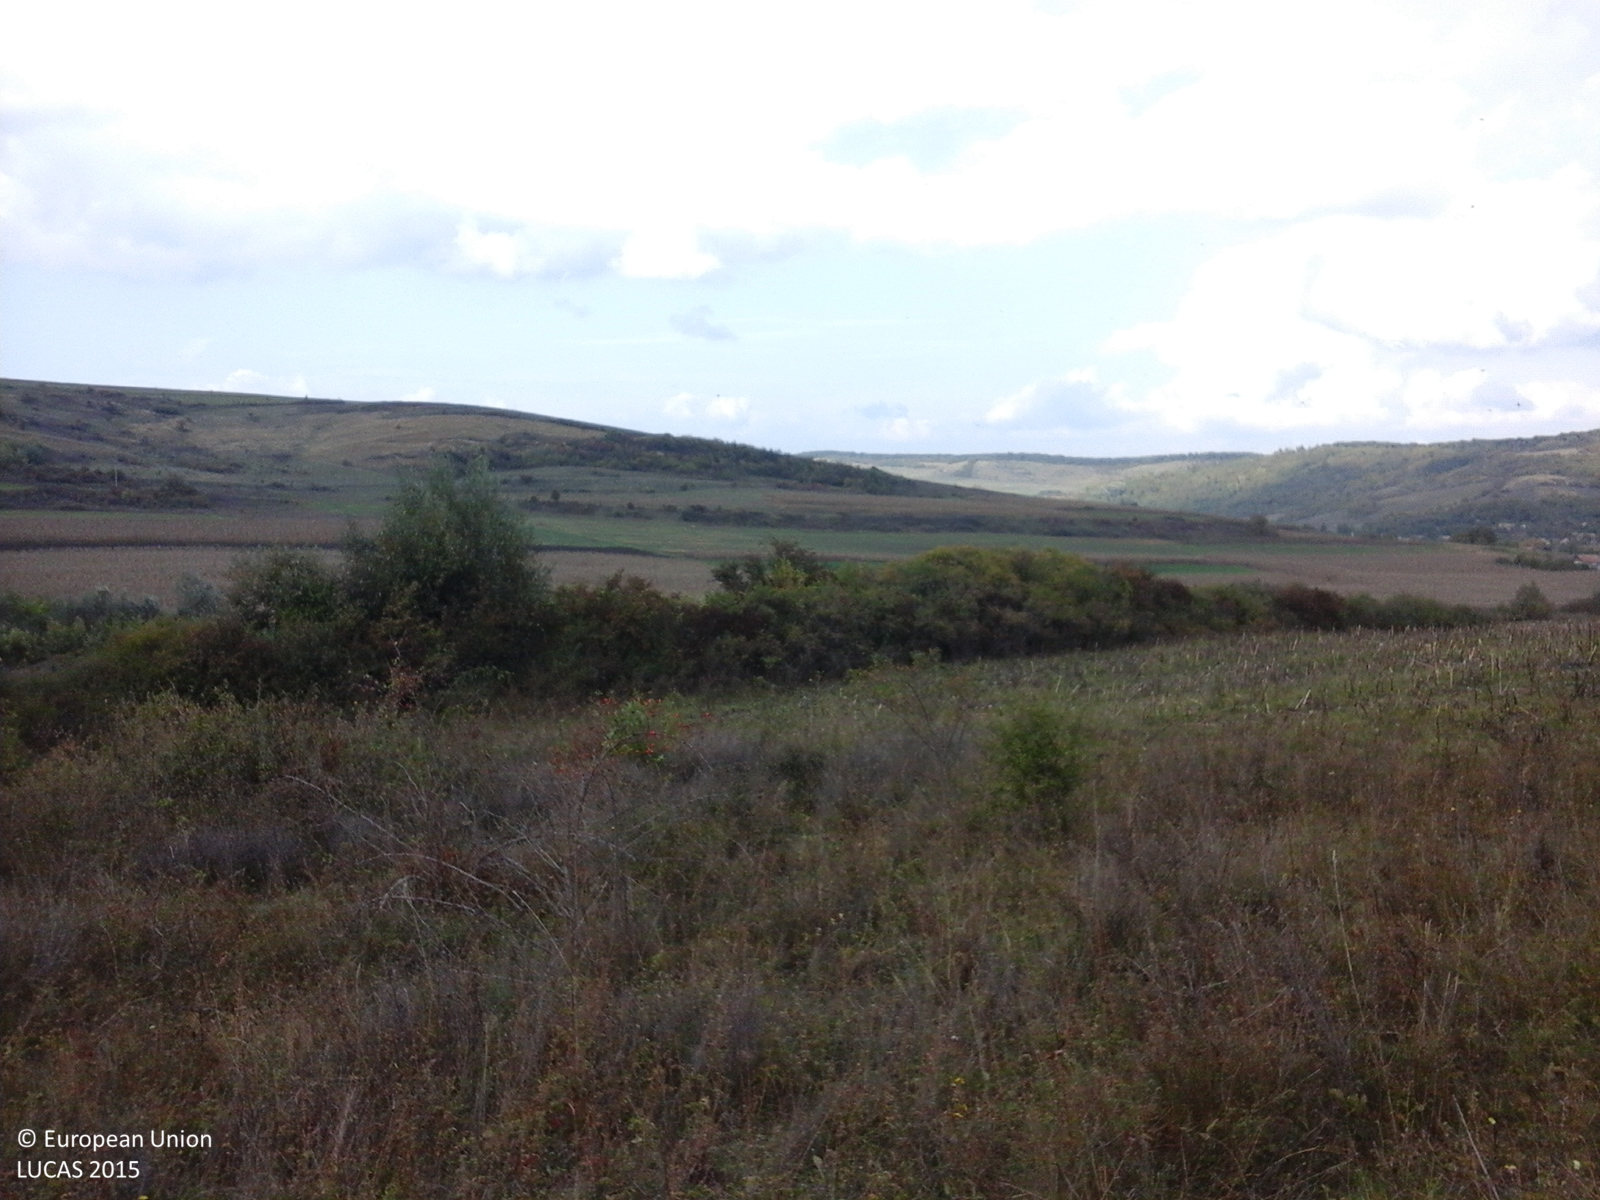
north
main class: Grassland
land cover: Grassland with sparse tree/shrub cover
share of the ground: > 75 %
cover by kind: herbaceous plants 85 %, shrubs 10 %, broadleaved forest trees 5 %
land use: Fallow land
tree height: < 5 m
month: October
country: RO
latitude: 46.3834
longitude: 24.3466
